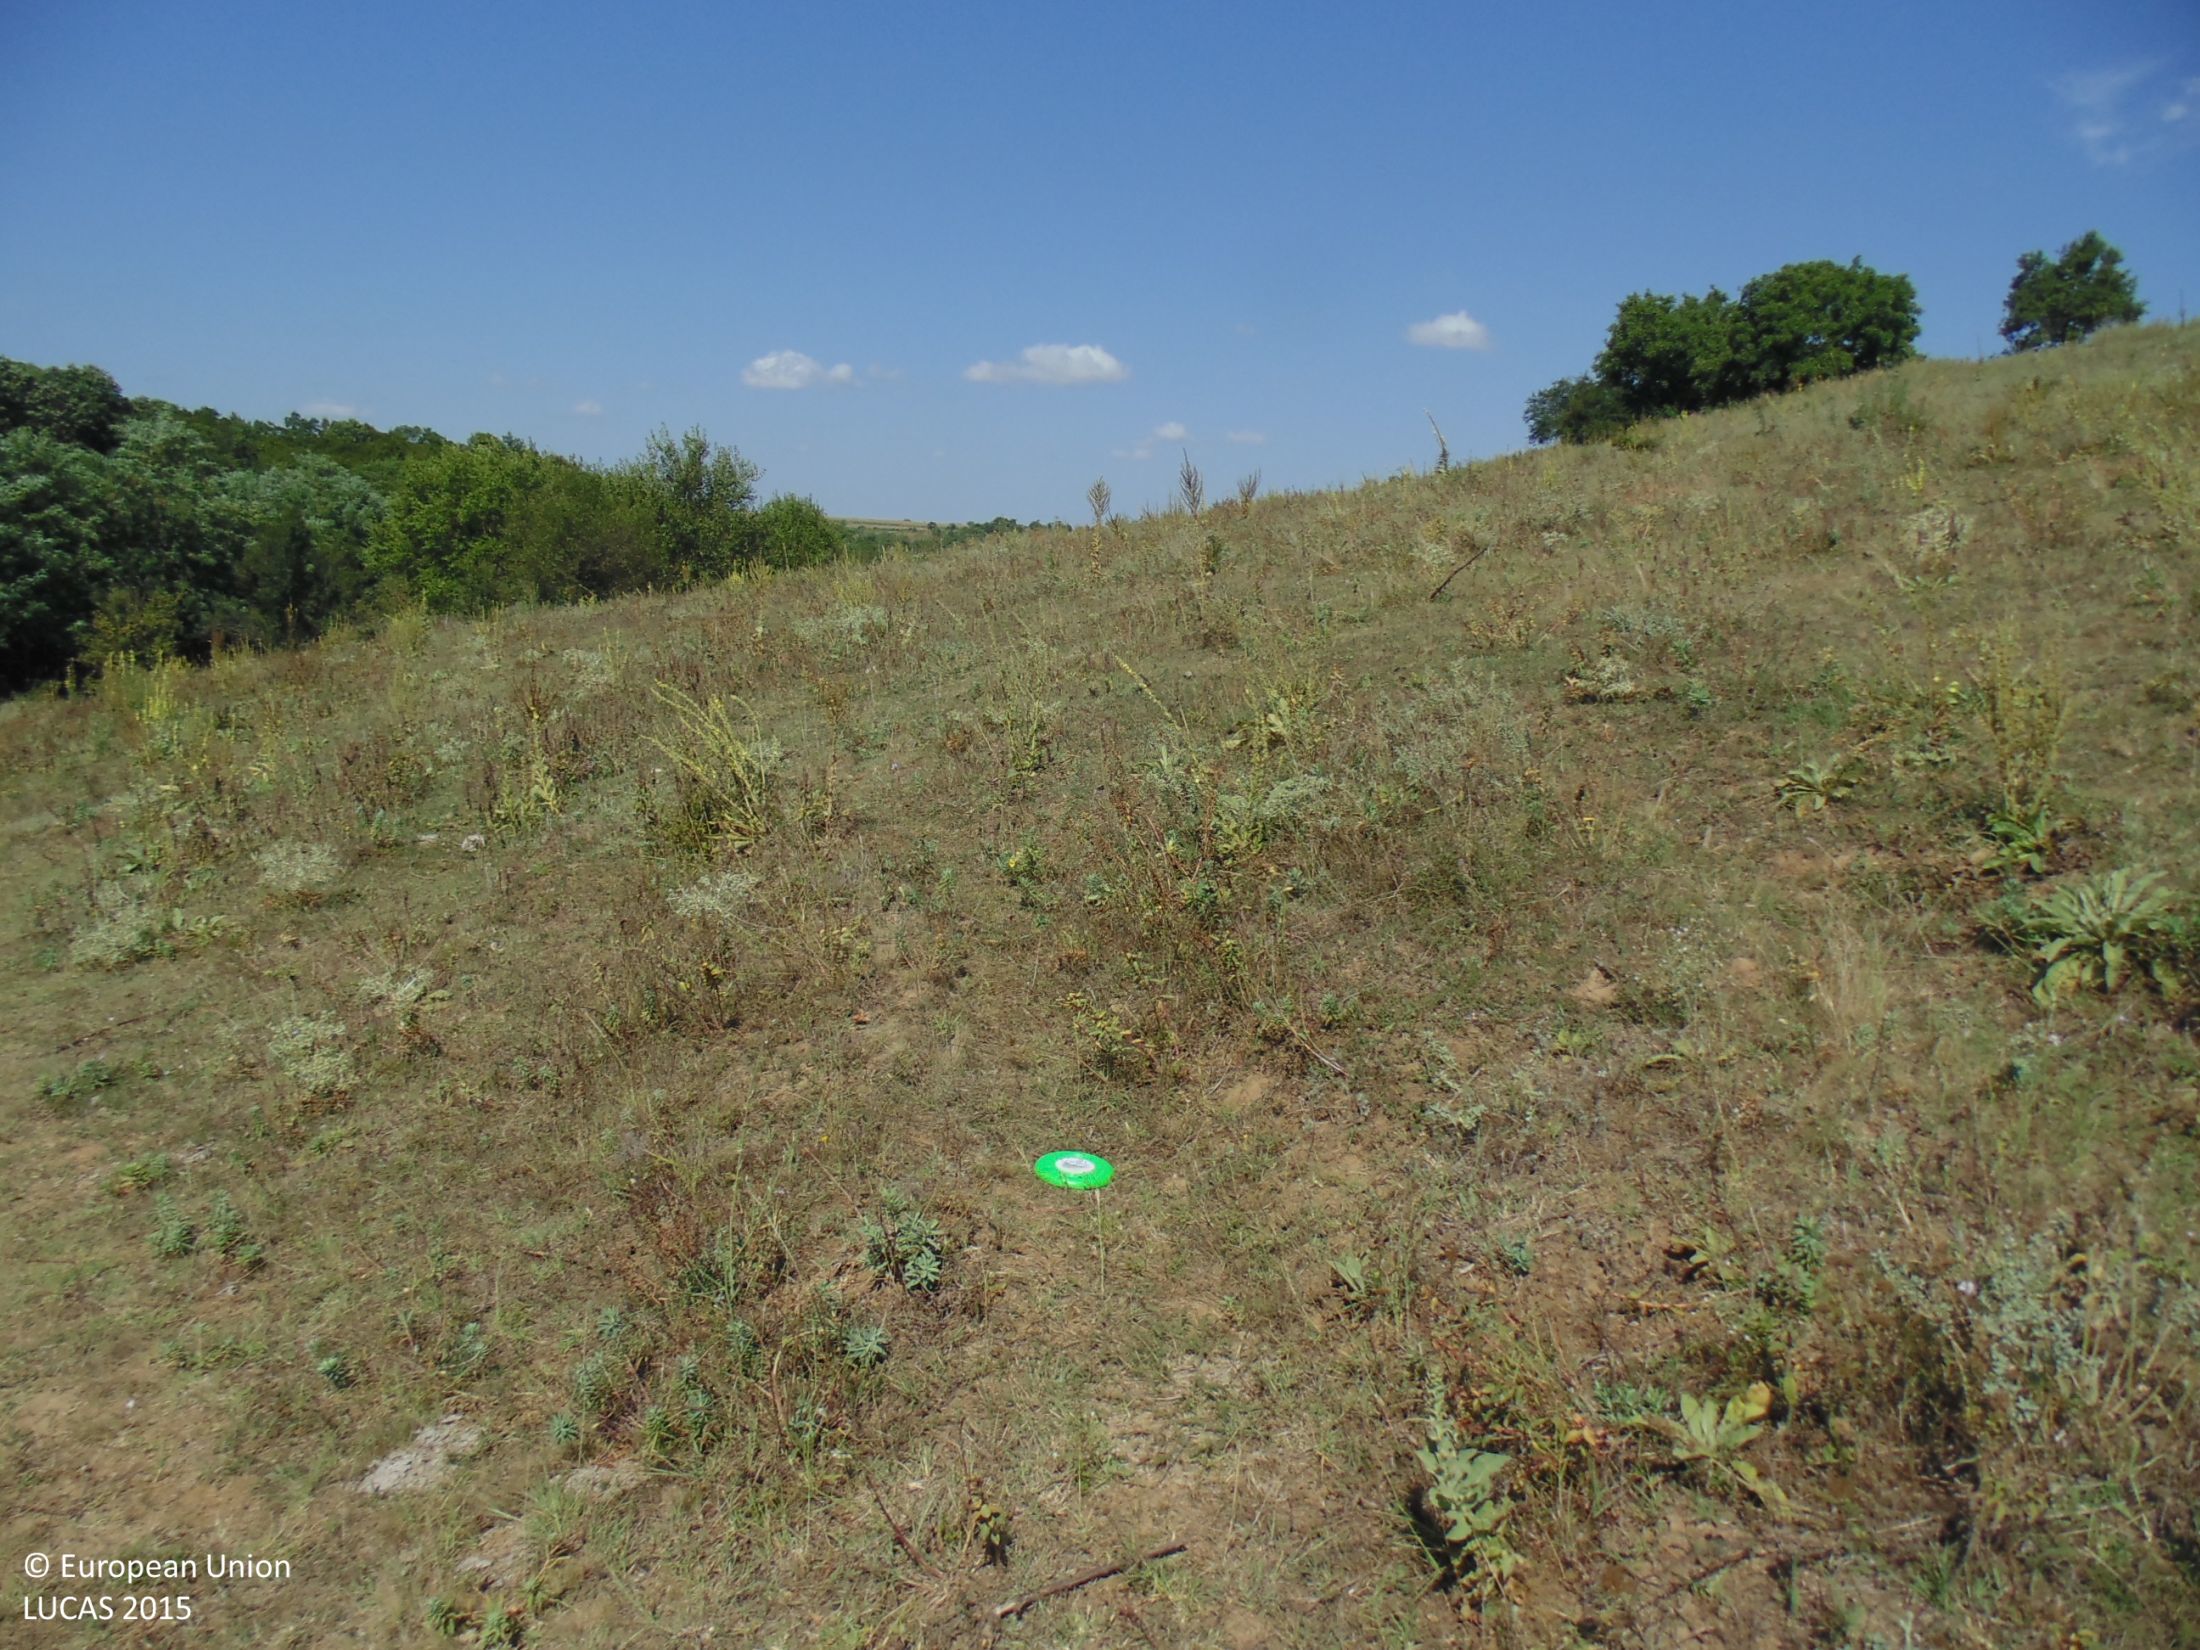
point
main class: Grassland
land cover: Grassland without tree/shrub cover
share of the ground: > 75 %
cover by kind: herbaceous plants 100 %
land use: Agriculture (excluding fallow land and kitchen gardens)
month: August
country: BG
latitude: 43.6397
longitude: 28.2406
